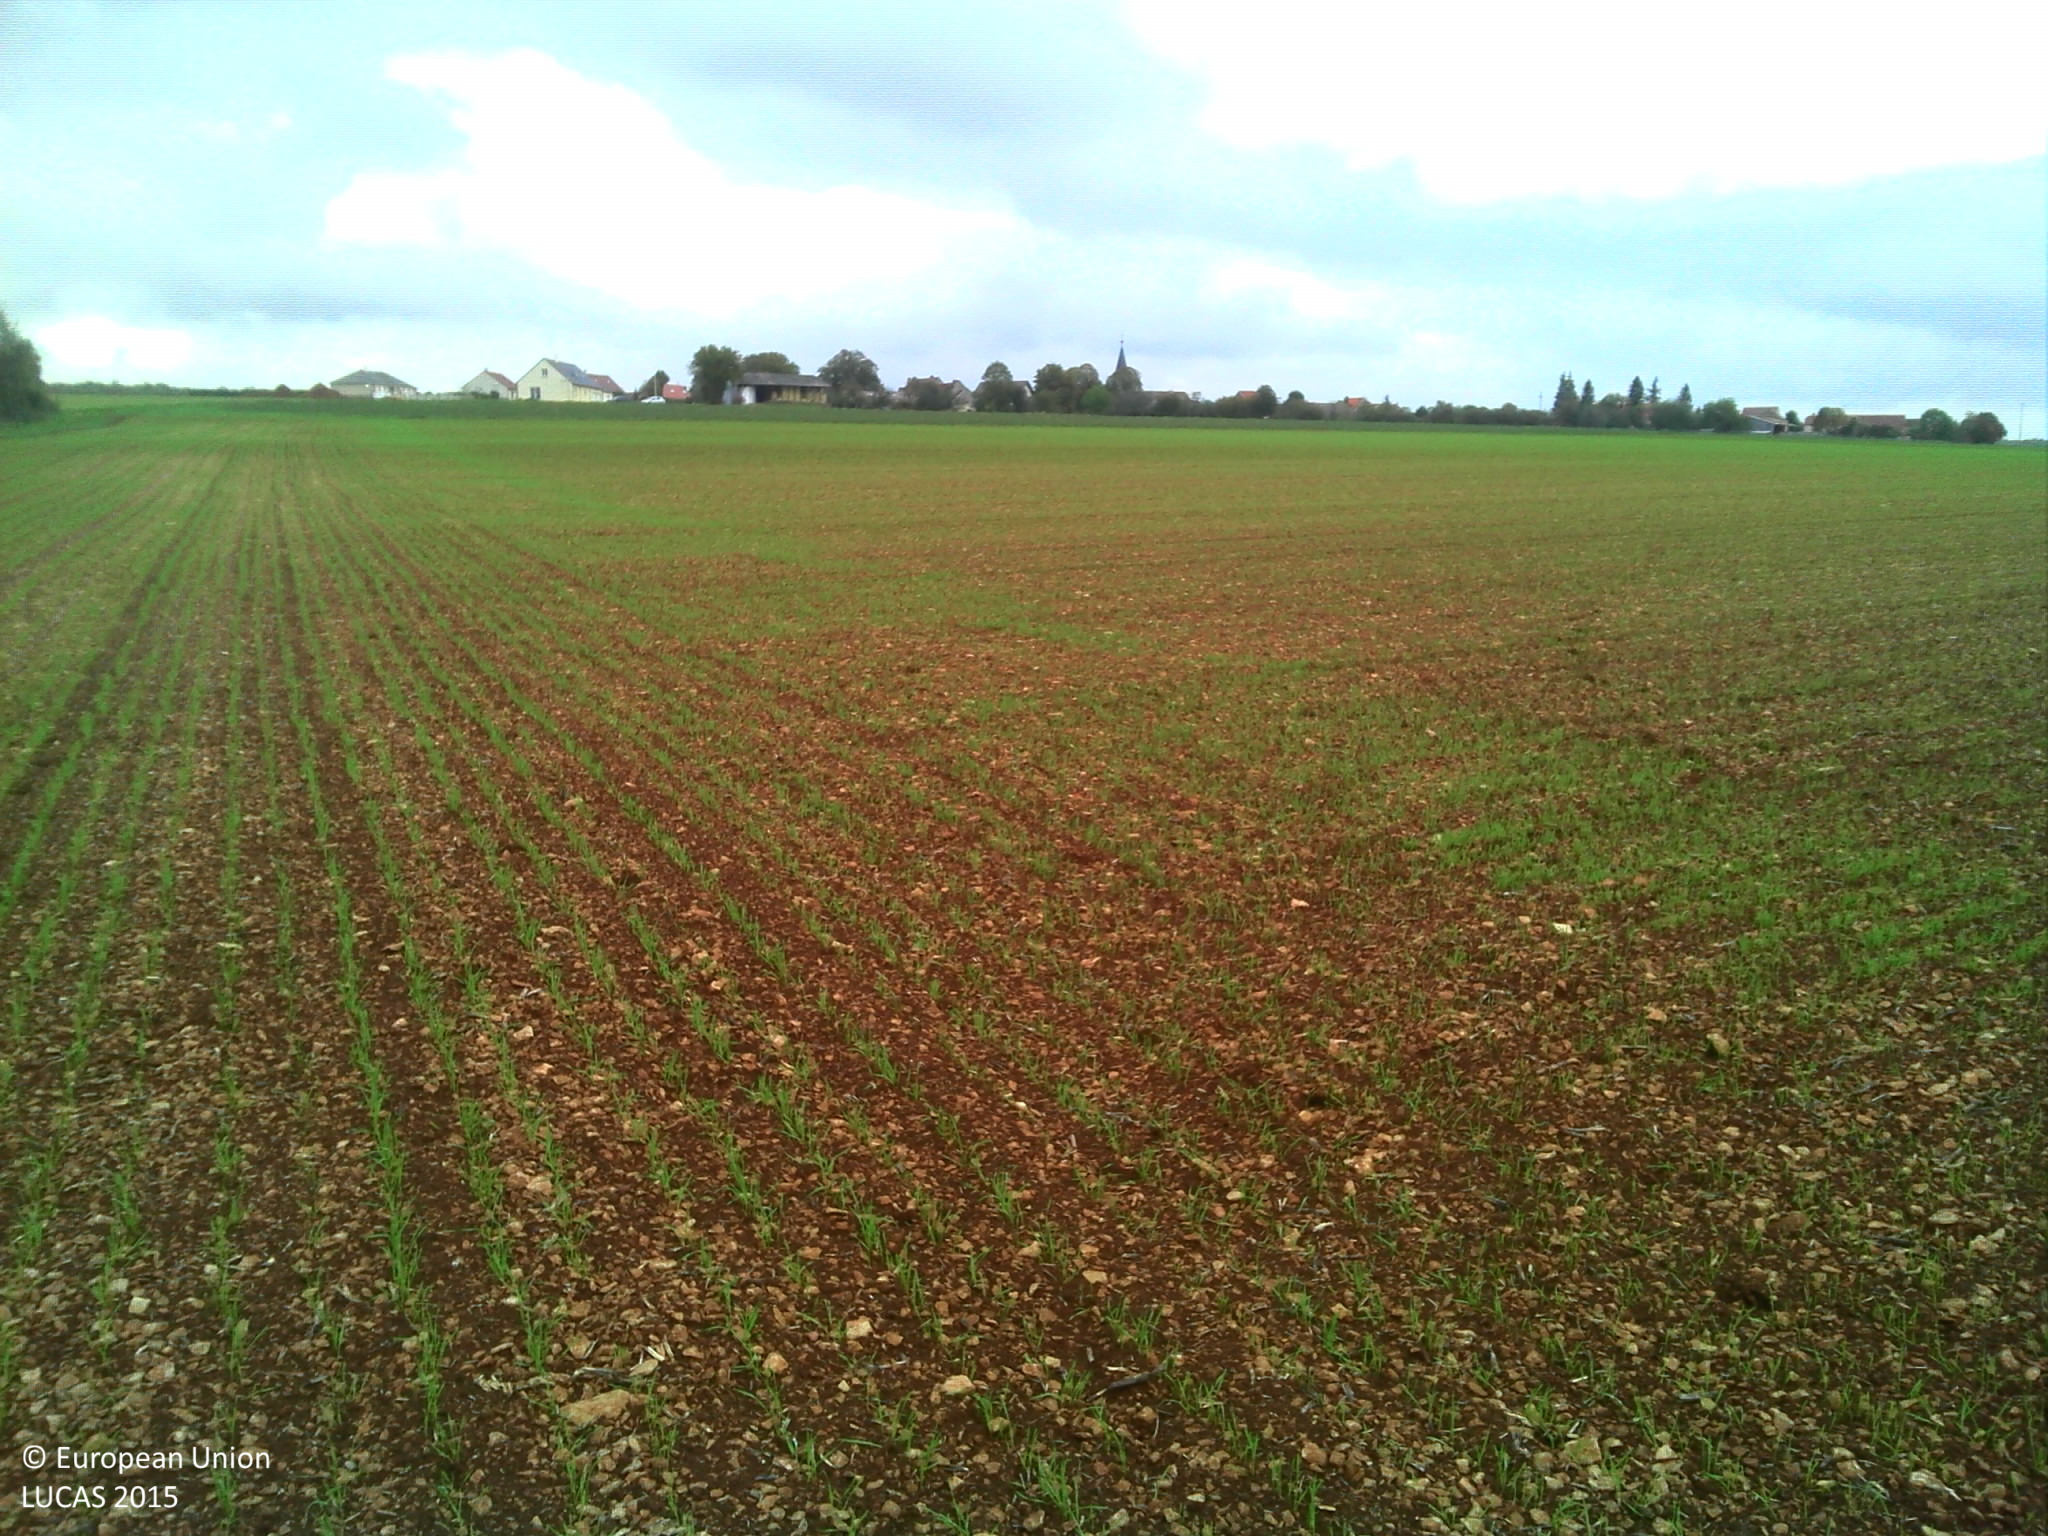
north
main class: Cropland
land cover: Temporary grasslands
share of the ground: 10 - 25 %
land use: Agriculture (excluding fallow land and kitchen gardens)
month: October
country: FR
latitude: 47.5687
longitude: 4.9887
